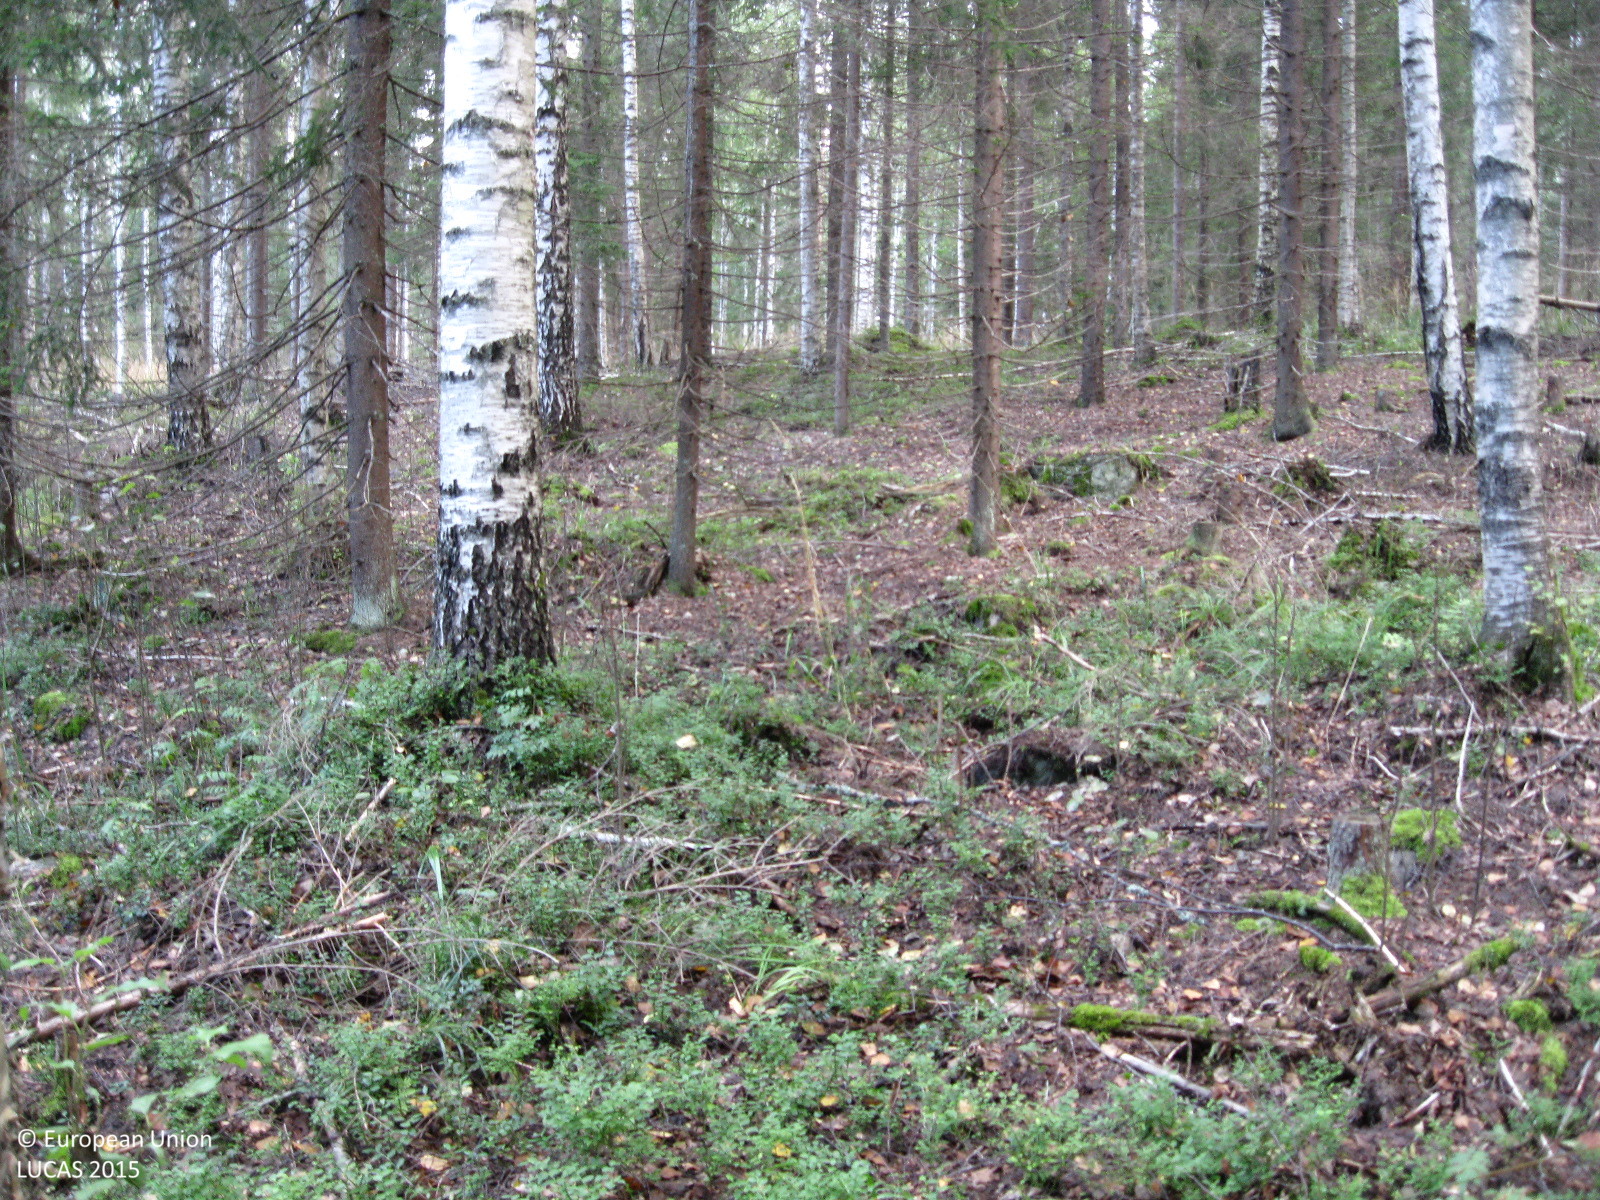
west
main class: Woodland
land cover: Spruce dominated mixed woodland
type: boreal forest
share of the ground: 50 - 75 %
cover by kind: coniferous forest trees 40 %, broadleaved forest trees 30 %, shrubs 20 %, herbaceous plants 10 %
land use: Forestry
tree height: > 5 m
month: September
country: FI
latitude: 60.6670
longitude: 24.9187
